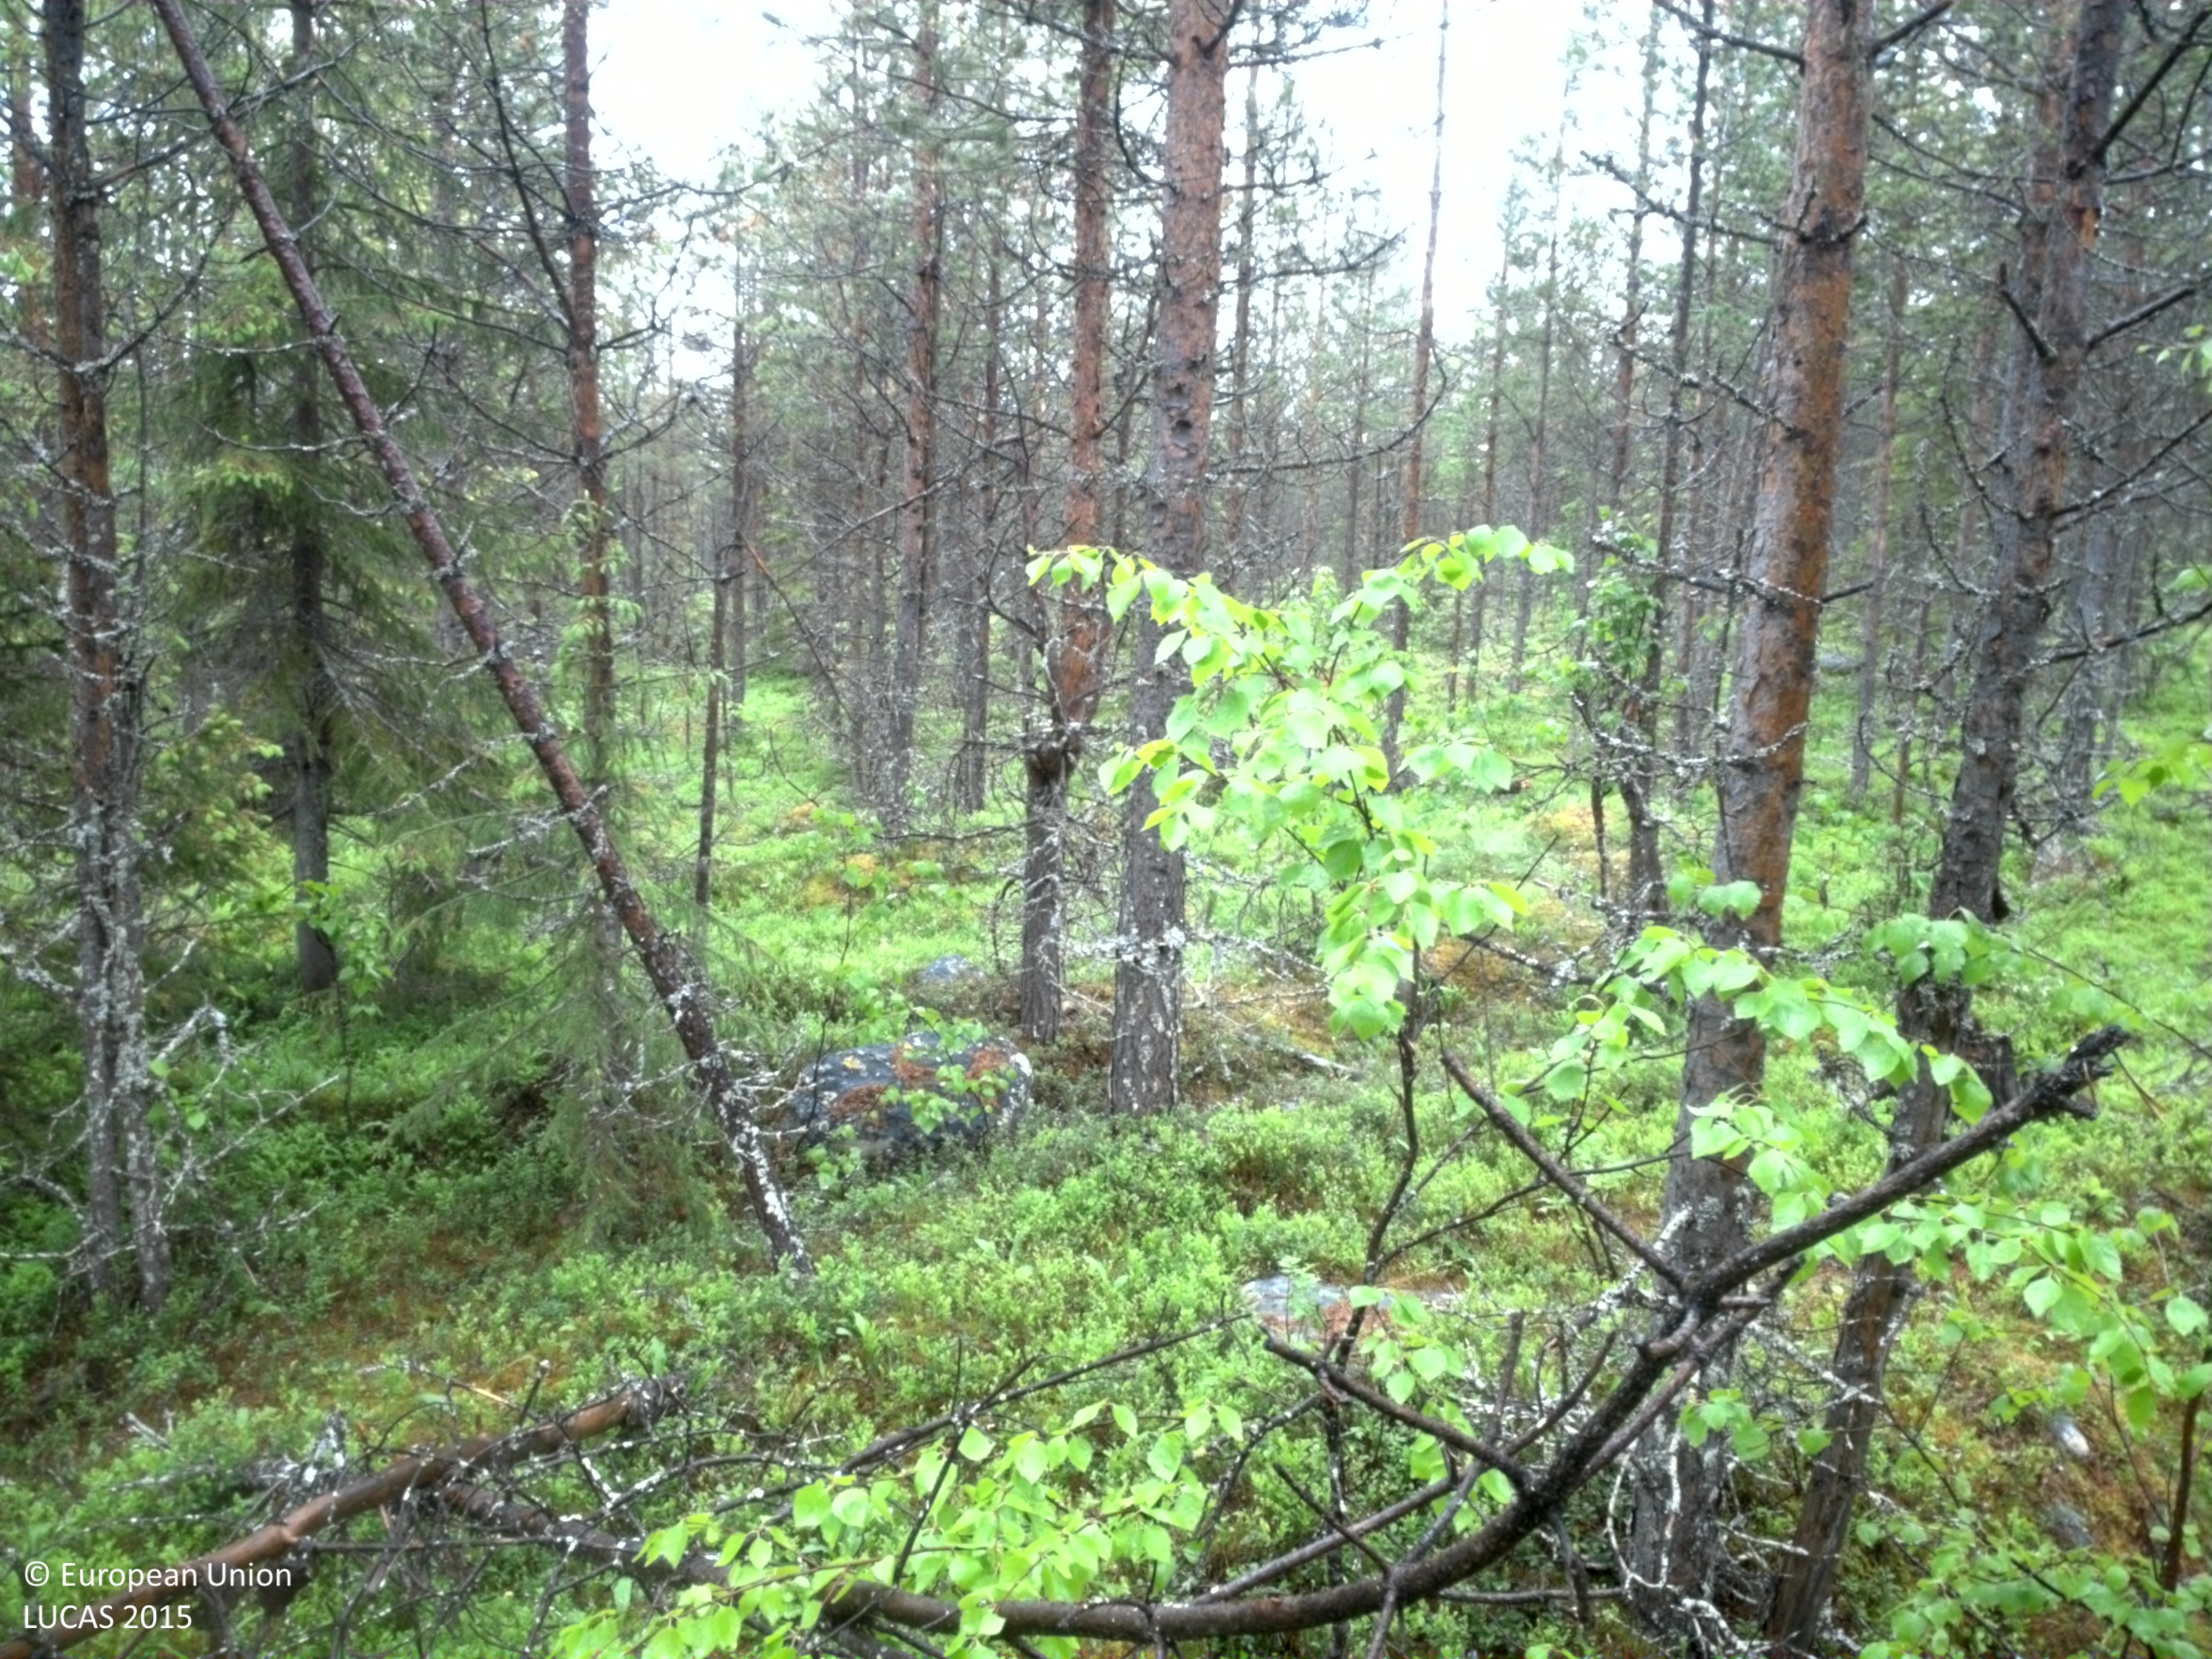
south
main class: Woodland
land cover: Pine dominated coniferous woodland
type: boreal forest
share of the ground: 25 - 50 %
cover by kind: shrubs 55 %, coniferous forest trees 40 %, broadleaved forest trees 5 %
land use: Forestry
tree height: > 5 m
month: June
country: SE
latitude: 66.5566
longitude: 22.8365
